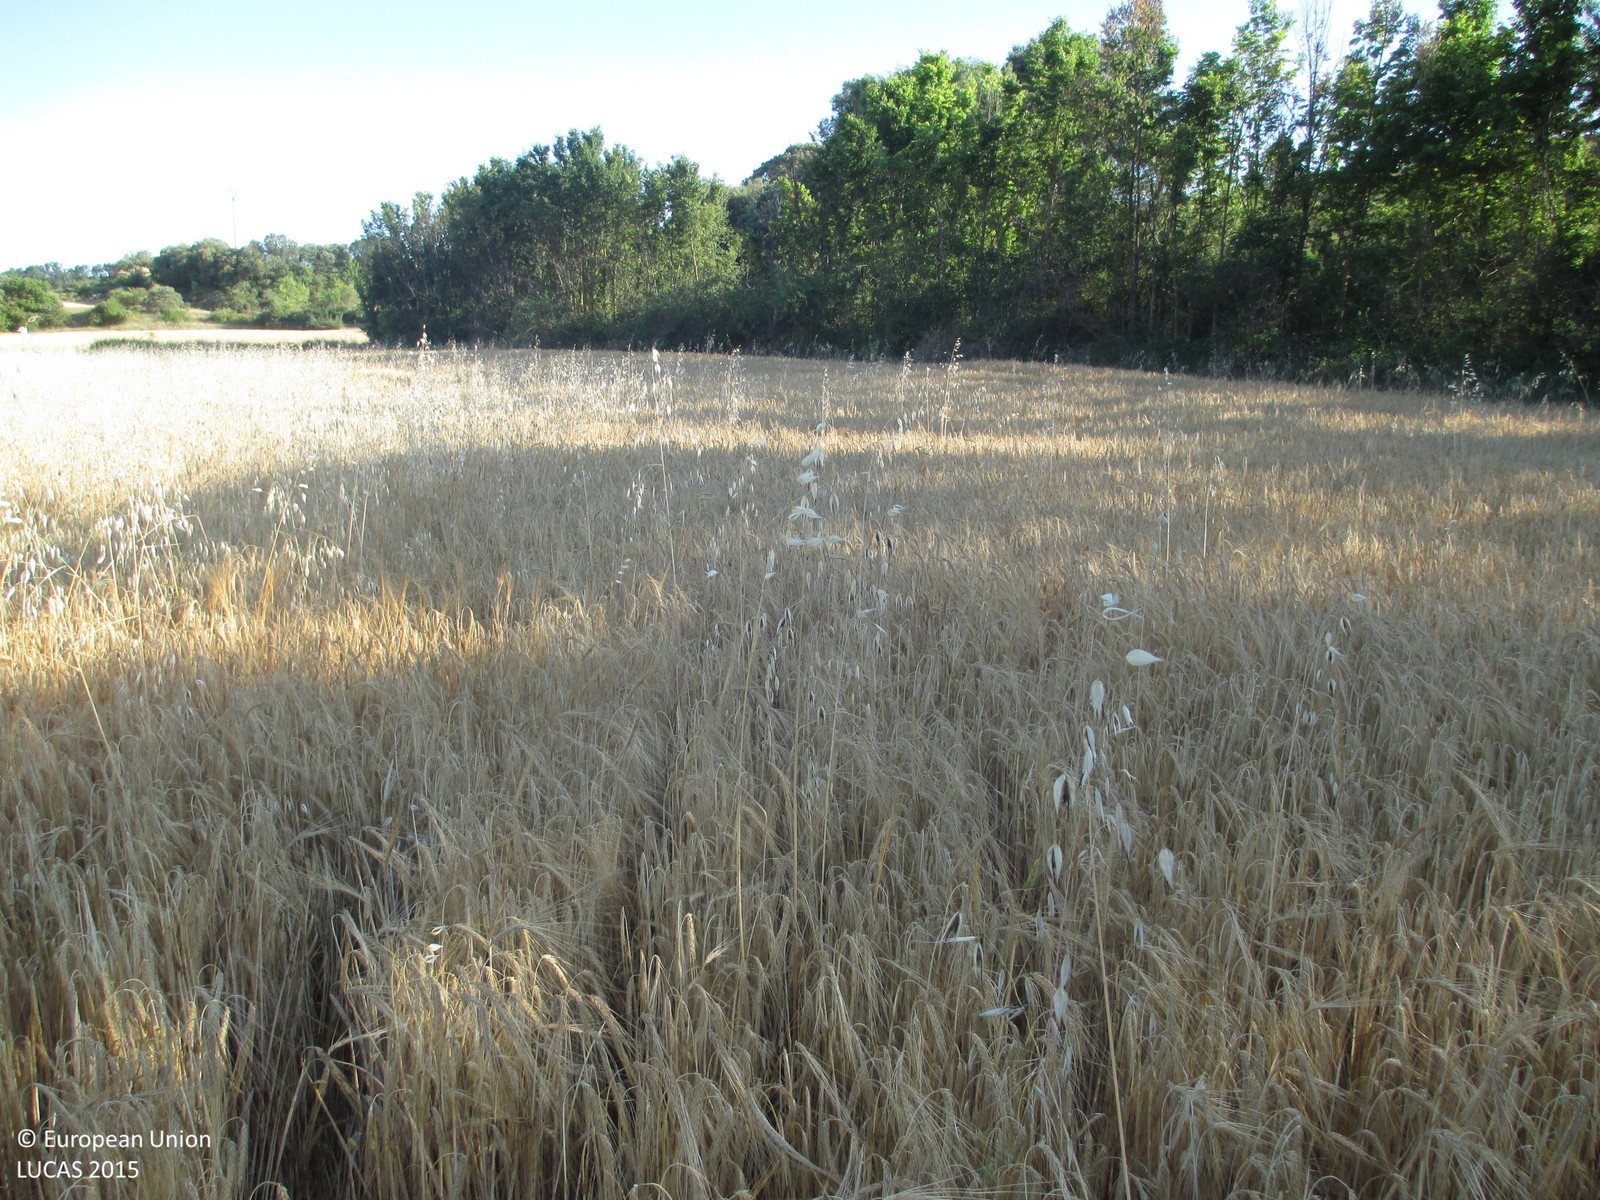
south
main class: Cropland
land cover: Barley
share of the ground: > 75 %
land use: Agriculture (excluding fallow land and kitchen gardens)
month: June
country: ES
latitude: 42.1372
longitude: -0.0257
